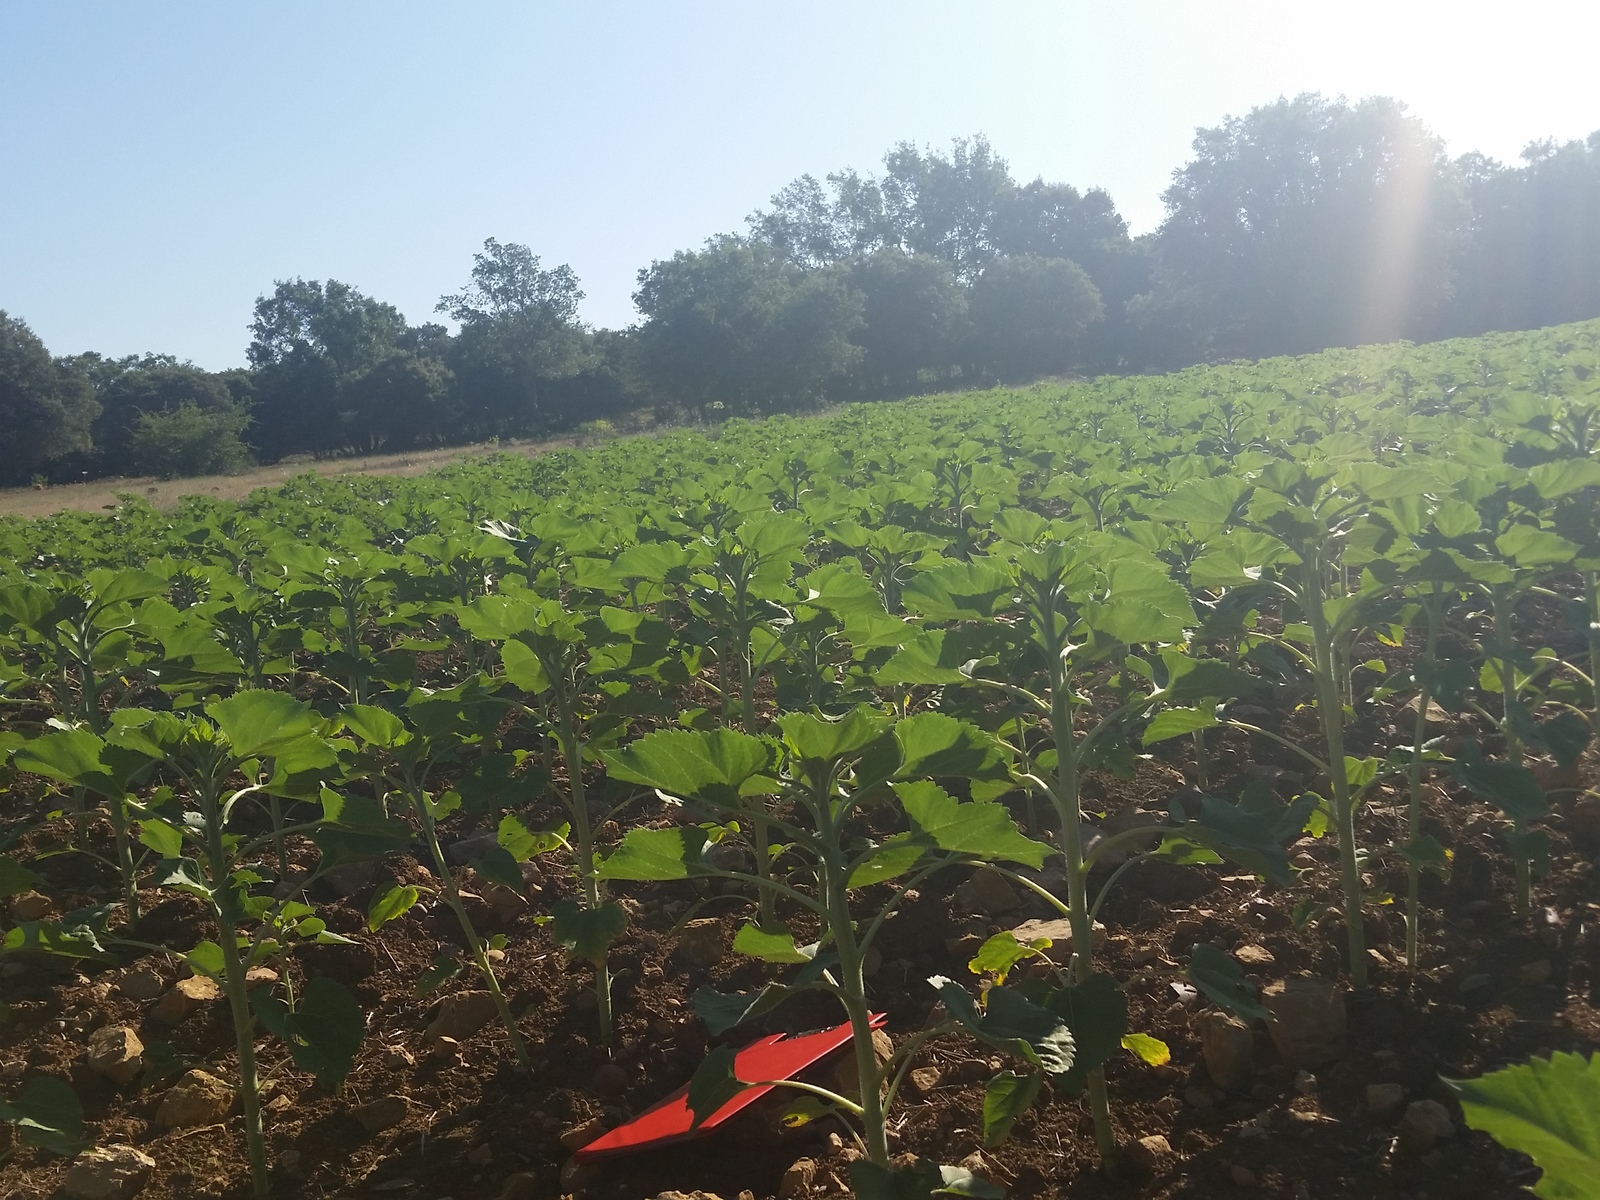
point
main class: Cropland
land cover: Sunflower
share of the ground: > 75 %
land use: Agriculture (excluding fallow land and kitchen gardens)
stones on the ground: 10 - 25 %
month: June
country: ES
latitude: 38.7348
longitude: -2.4837
